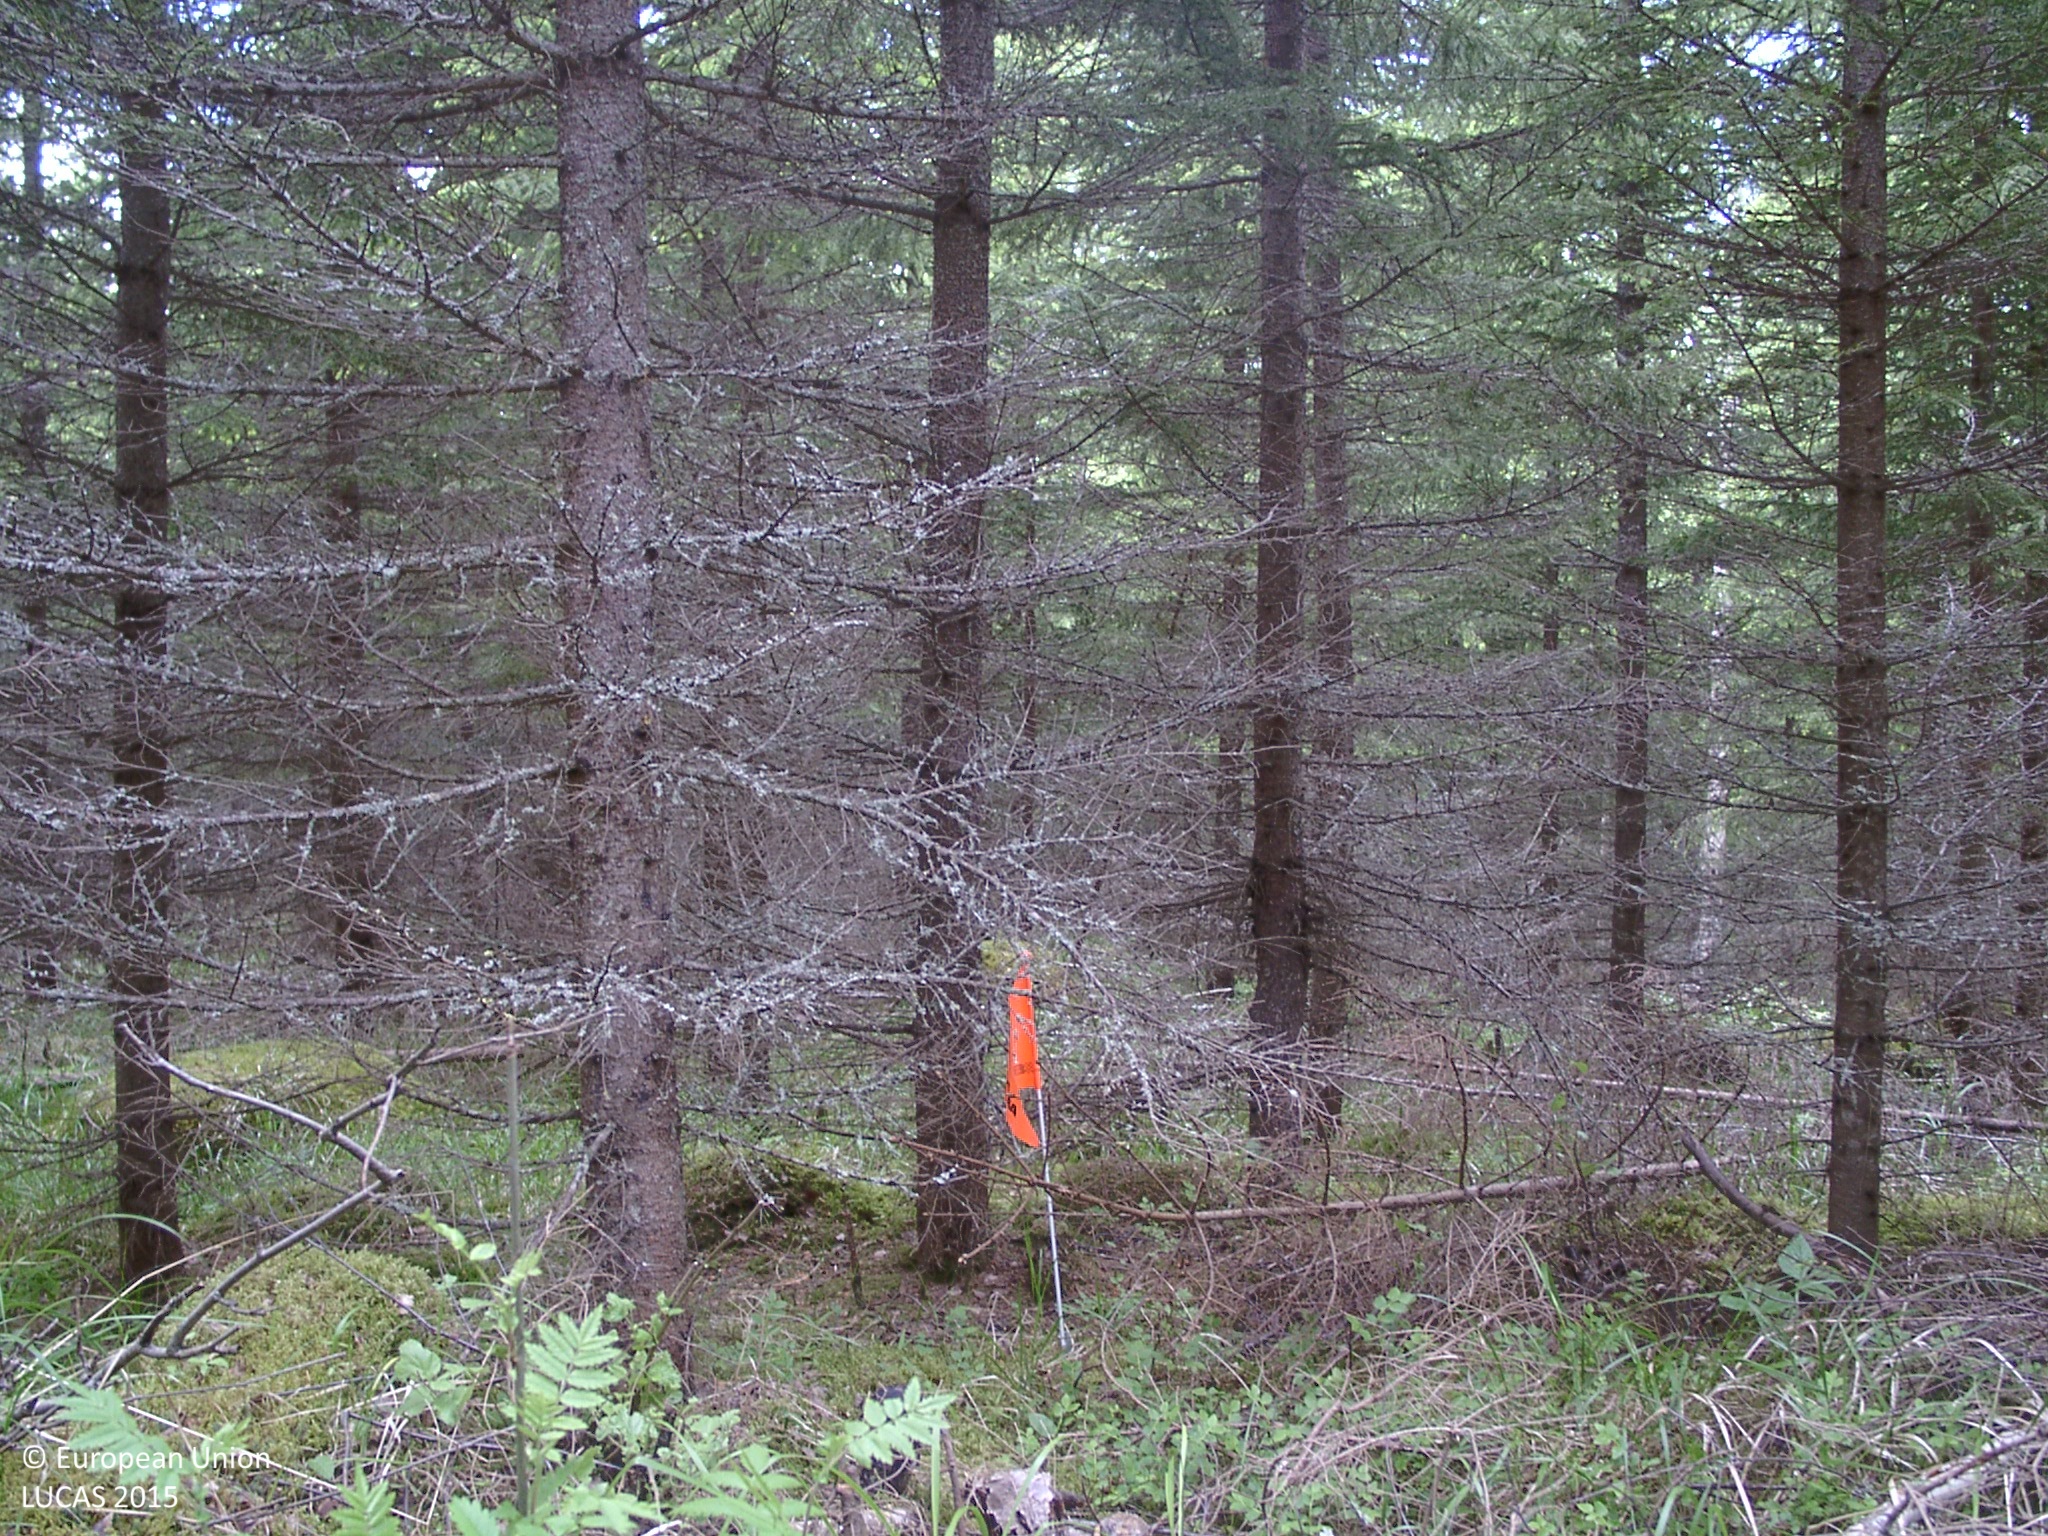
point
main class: Woodland
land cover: Spruce dominated coniferous woodland
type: boreal forest
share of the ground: 50 - 75 %
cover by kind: coniferous forest trees 70 %, herbaceous plants 20 %, lichens and mosses 10 %
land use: Forestry
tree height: > 5 m
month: June
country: FI
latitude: 61.7722
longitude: 24.9068
